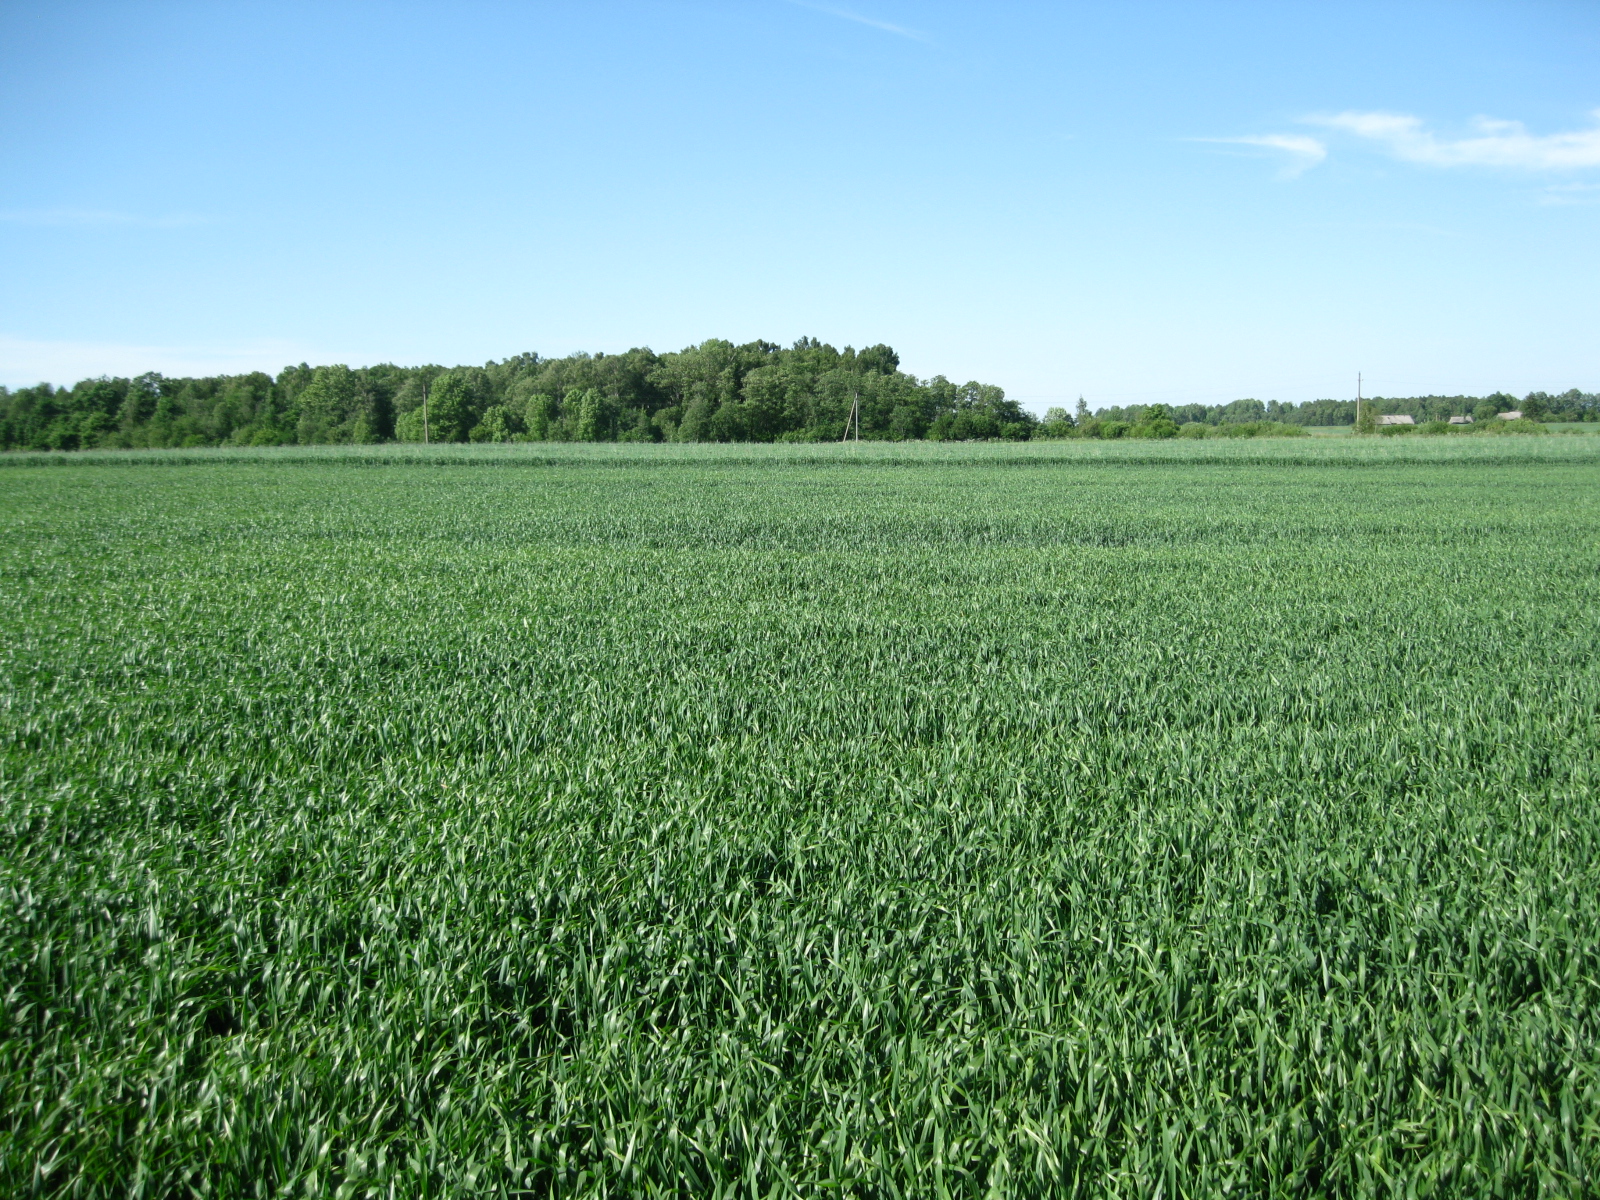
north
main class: Cropland
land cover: Common wheat
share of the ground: > 75 %
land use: Agriculture (excluding fallow land and kitchen gardens)
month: June
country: LT
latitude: 55.8323
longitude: 23.8634
